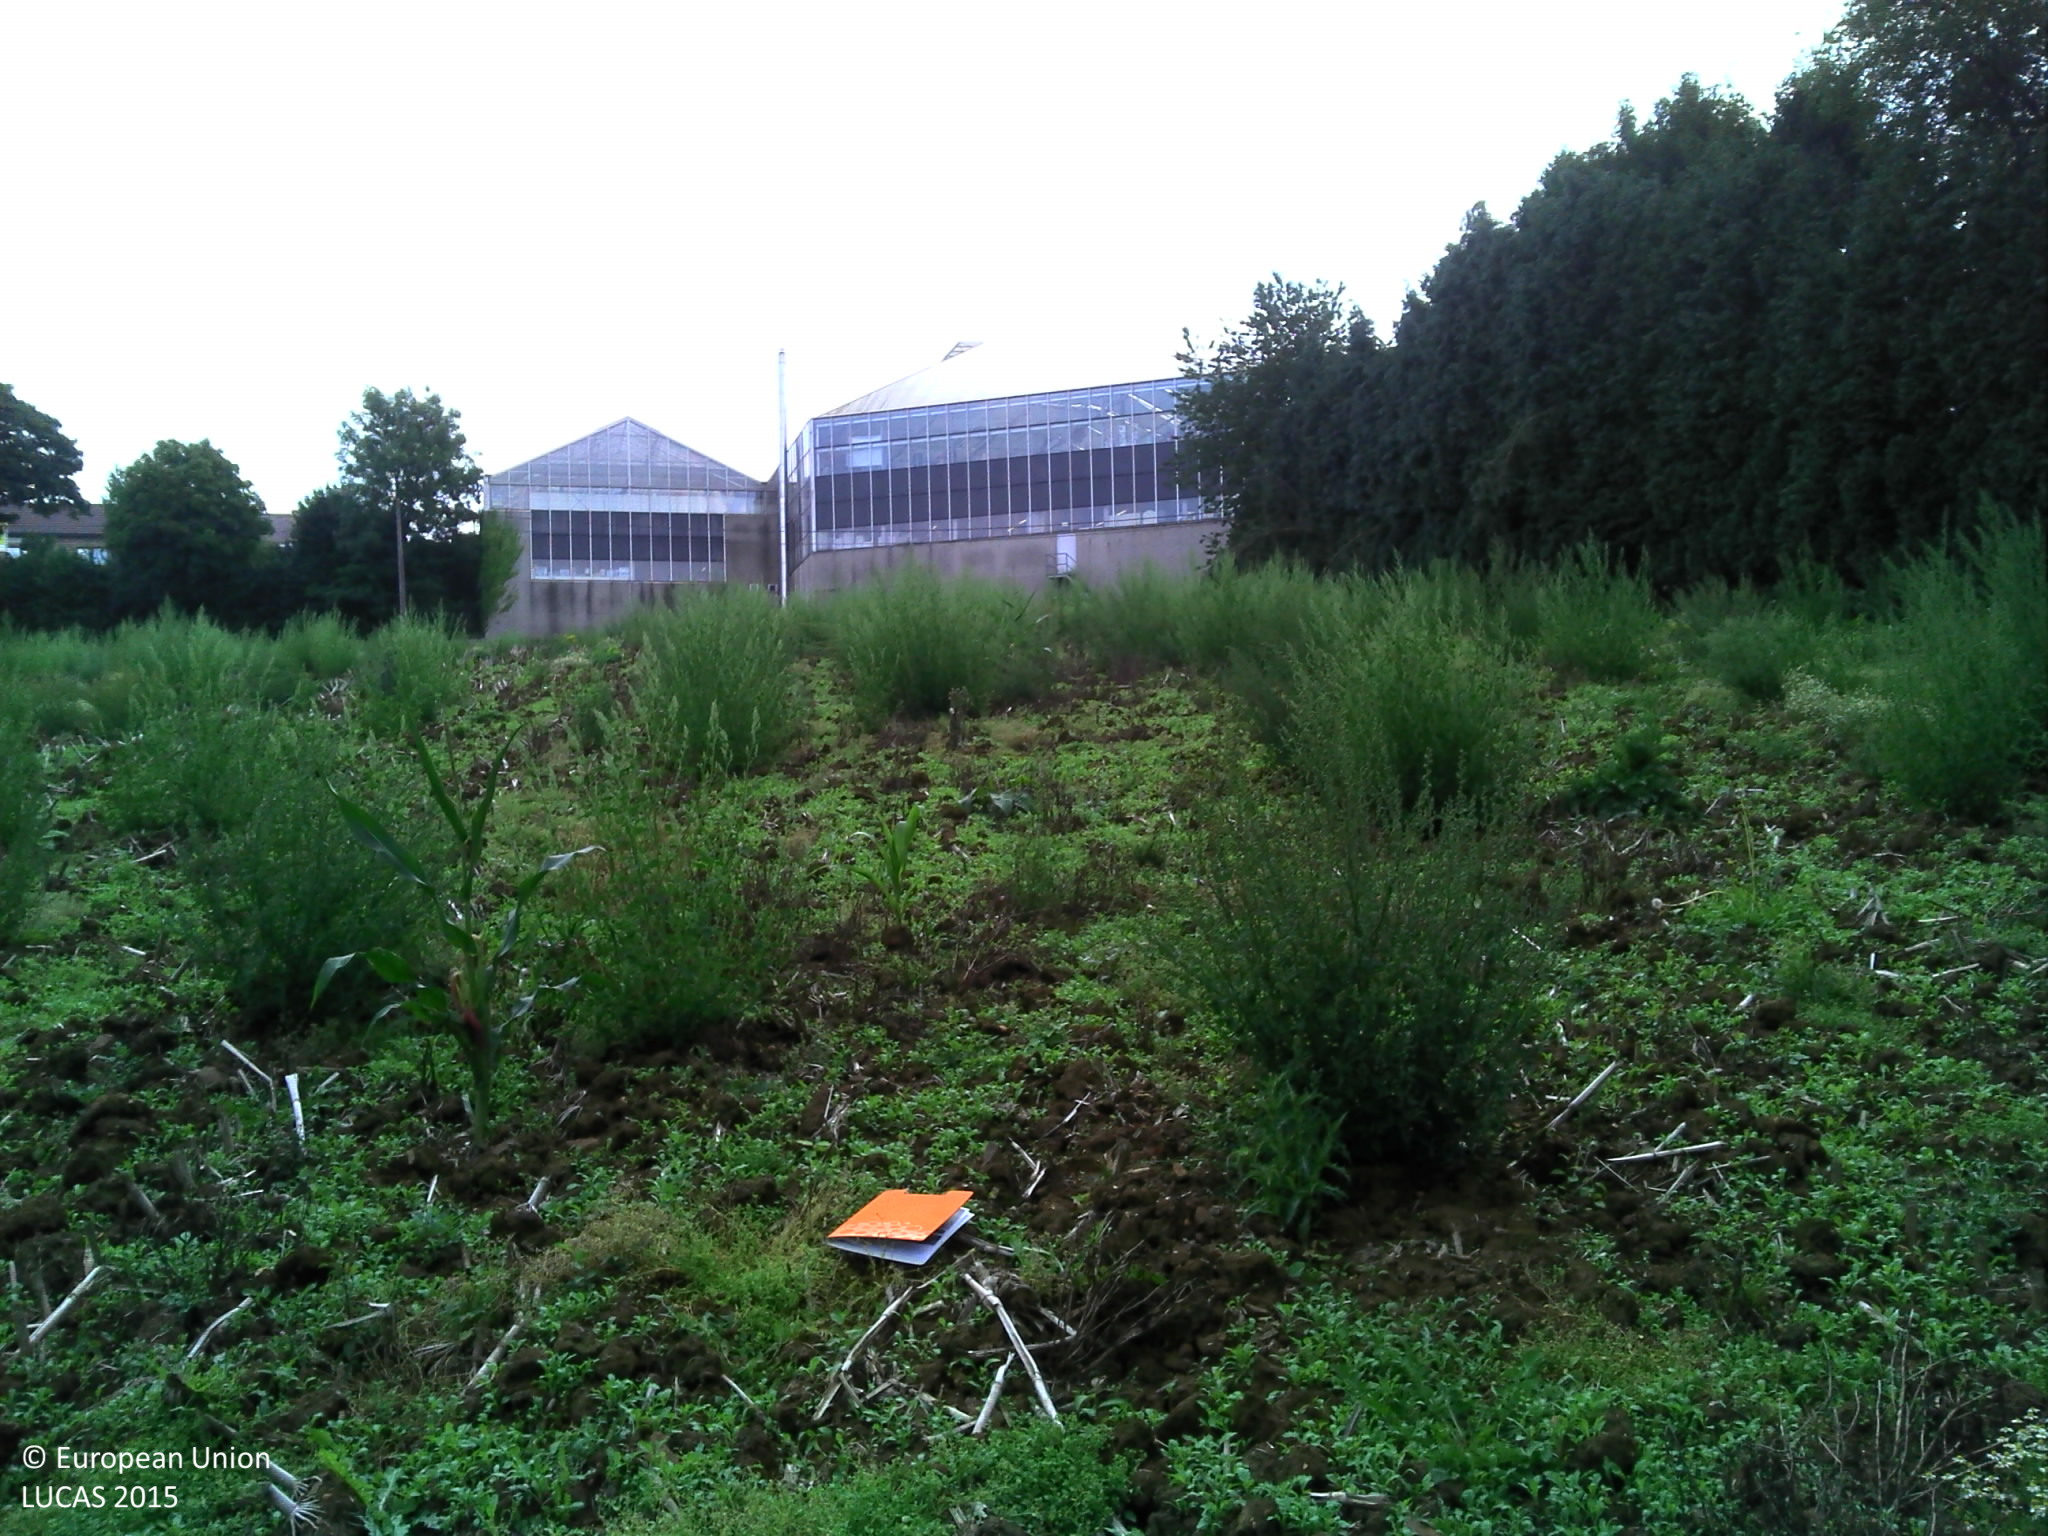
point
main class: Grassland
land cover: Spontaneously vegetated surfaces
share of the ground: > 75 %
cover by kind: herbaceous plants 50 %, unconsolidated bare surface 50 %
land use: Fallow land
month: August
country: BE
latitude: 50.7832
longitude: 2.7408
